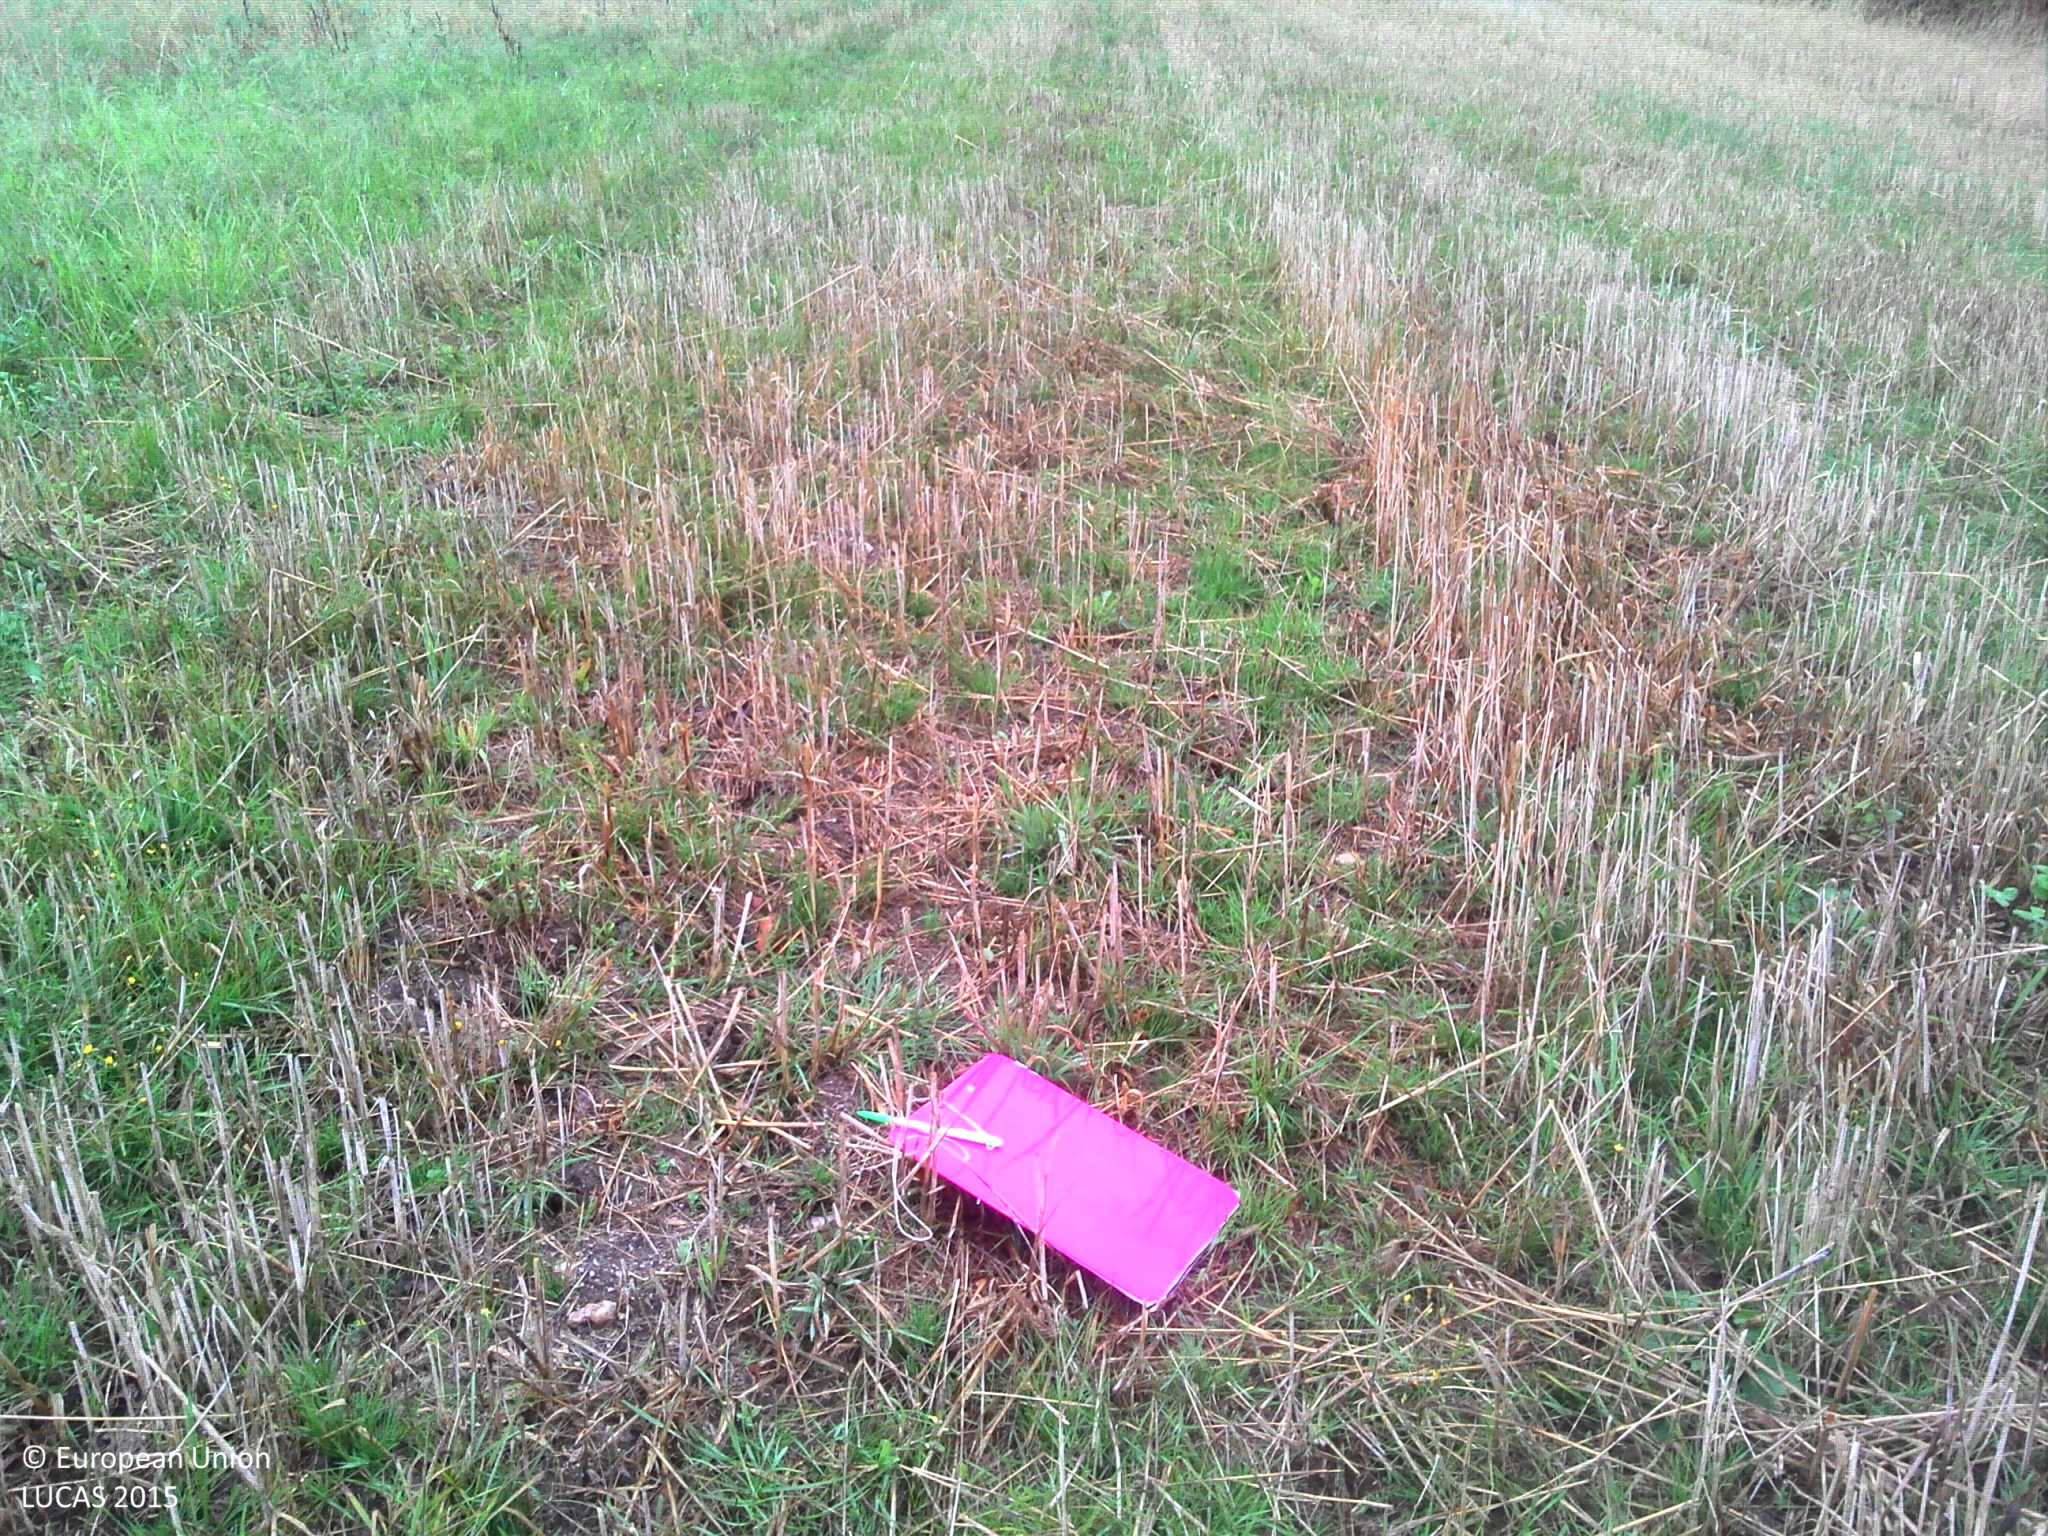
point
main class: Cropland
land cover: Barley
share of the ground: > 75 %
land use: Agriculture (excluding fallow land and kitchen gardens)
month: August
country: FR
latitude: 46.0020
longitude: 0.9360
